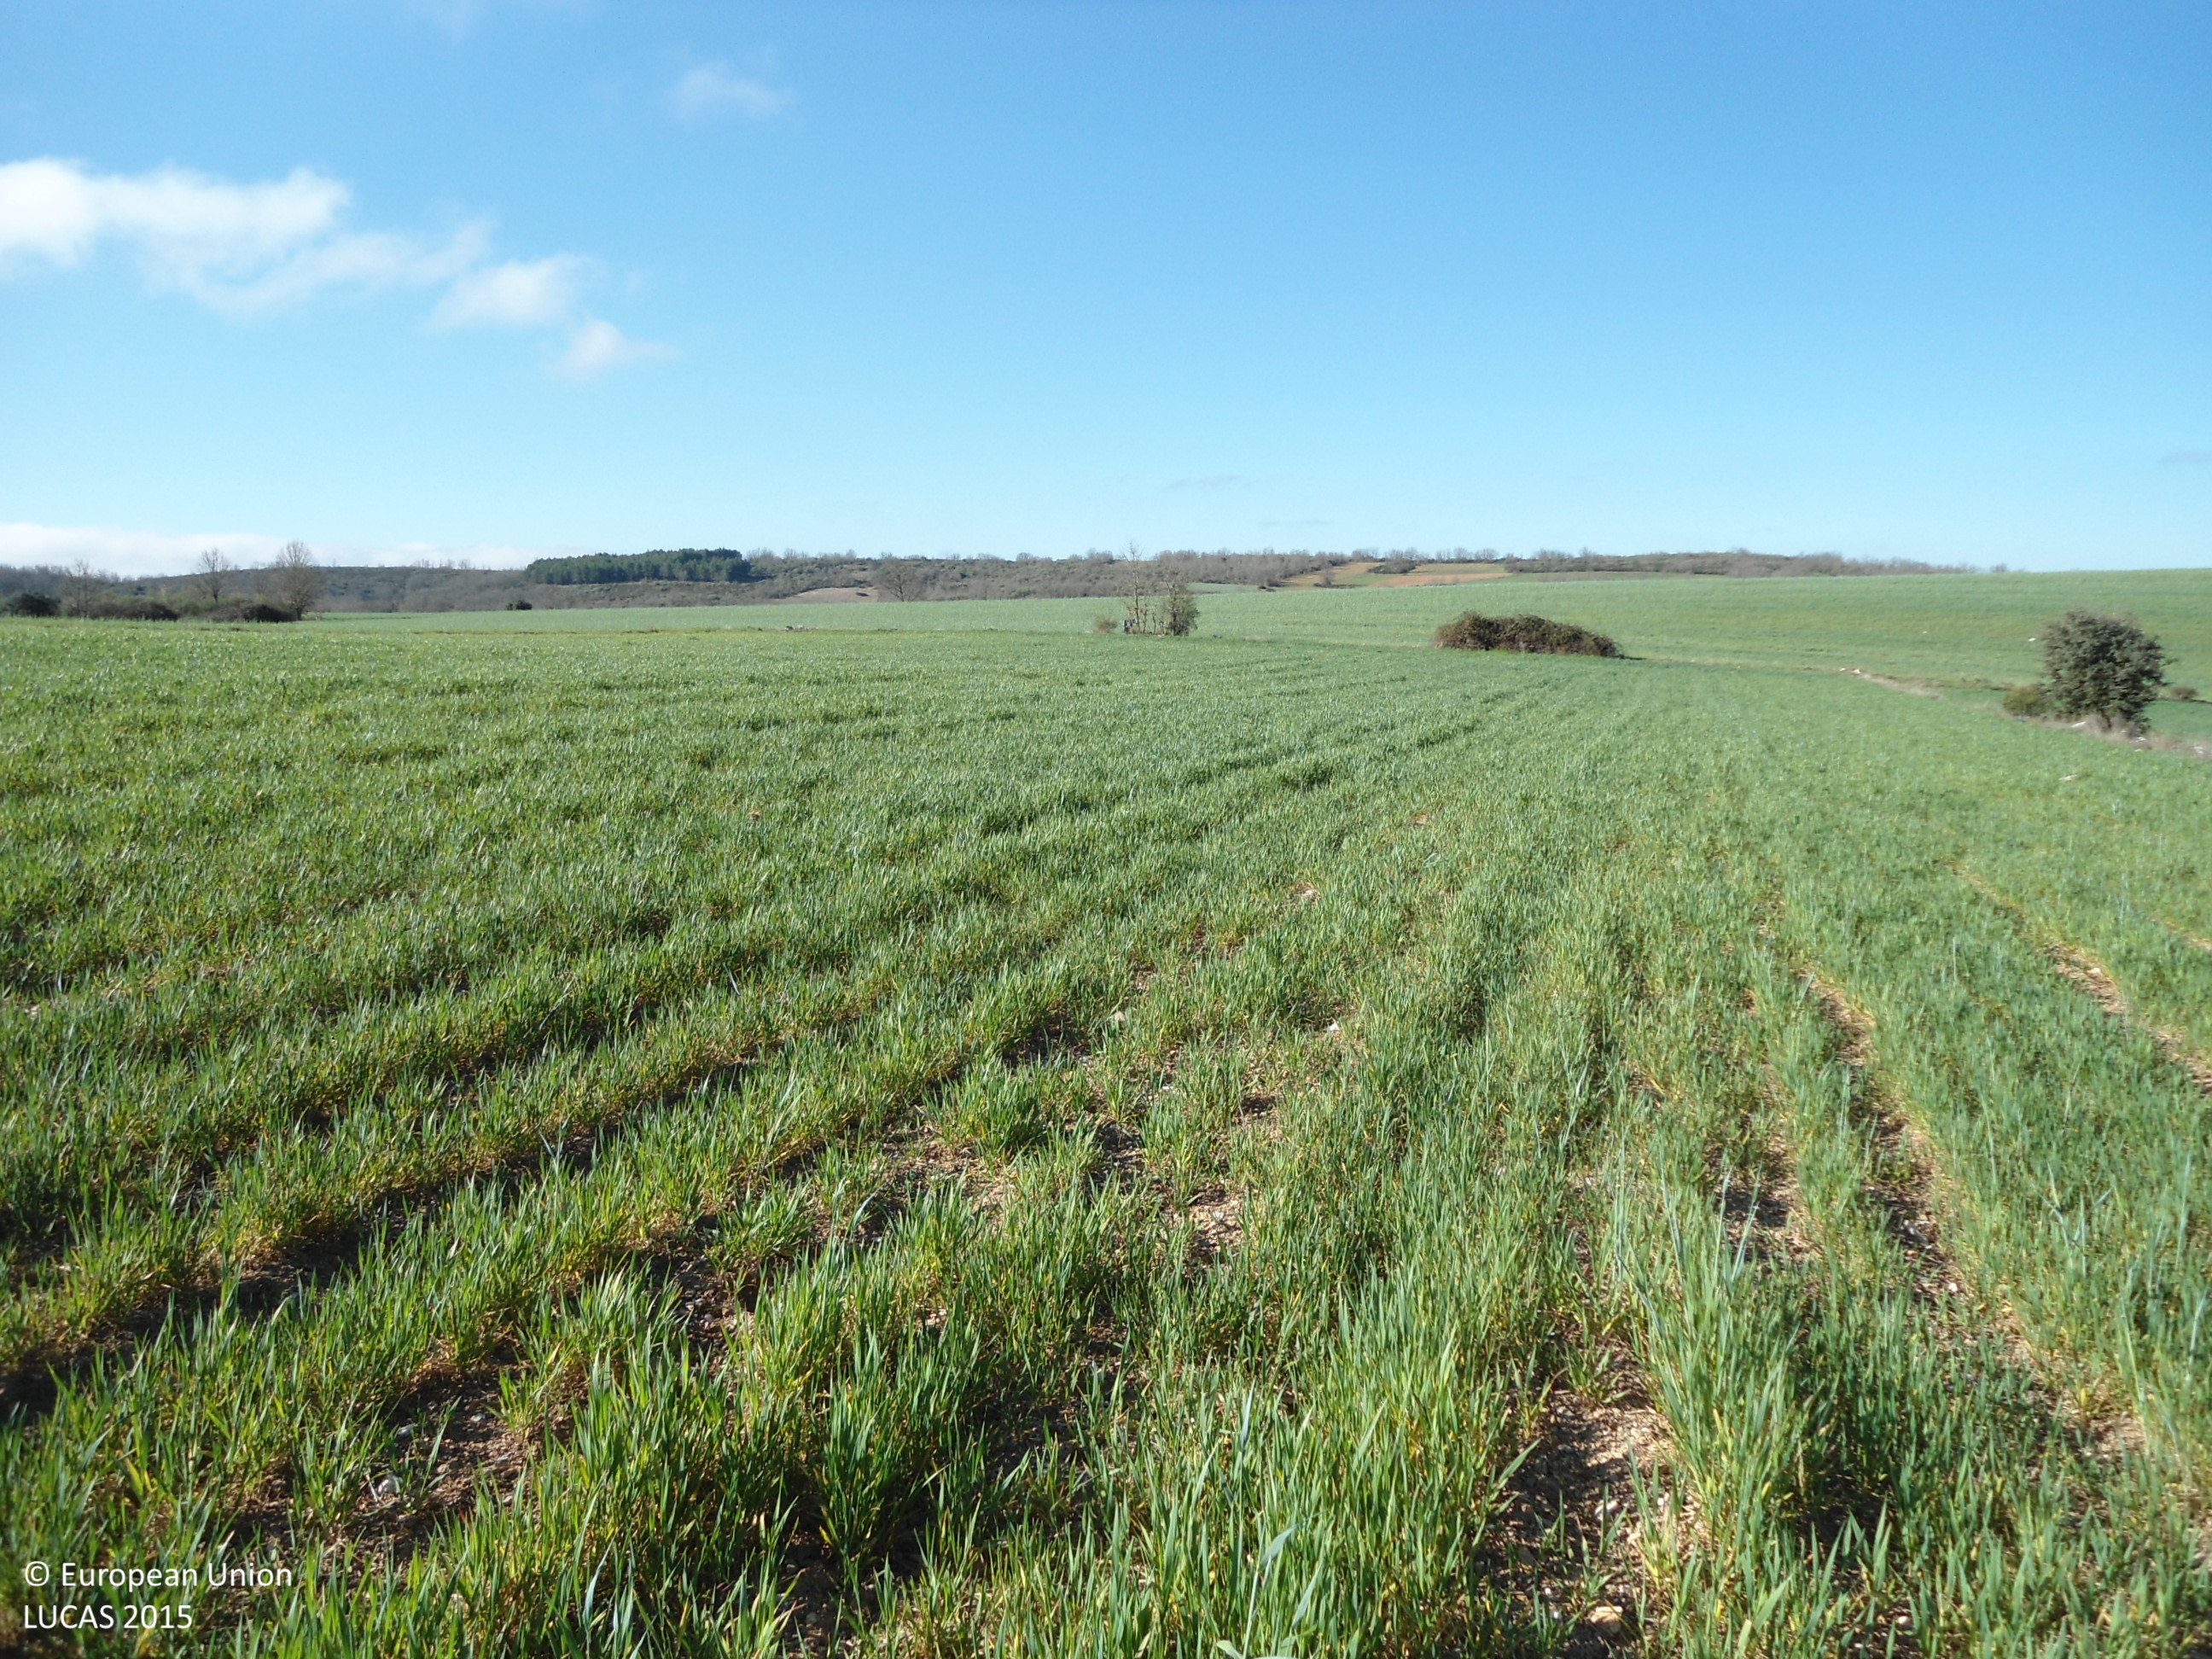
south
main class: Cropland
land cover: Common wheat
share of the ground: > 75 %
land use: Agriculture (excluding fallow land and kitchen gardens)
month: April
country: ES
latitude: 41.6638
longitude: -6.1298
